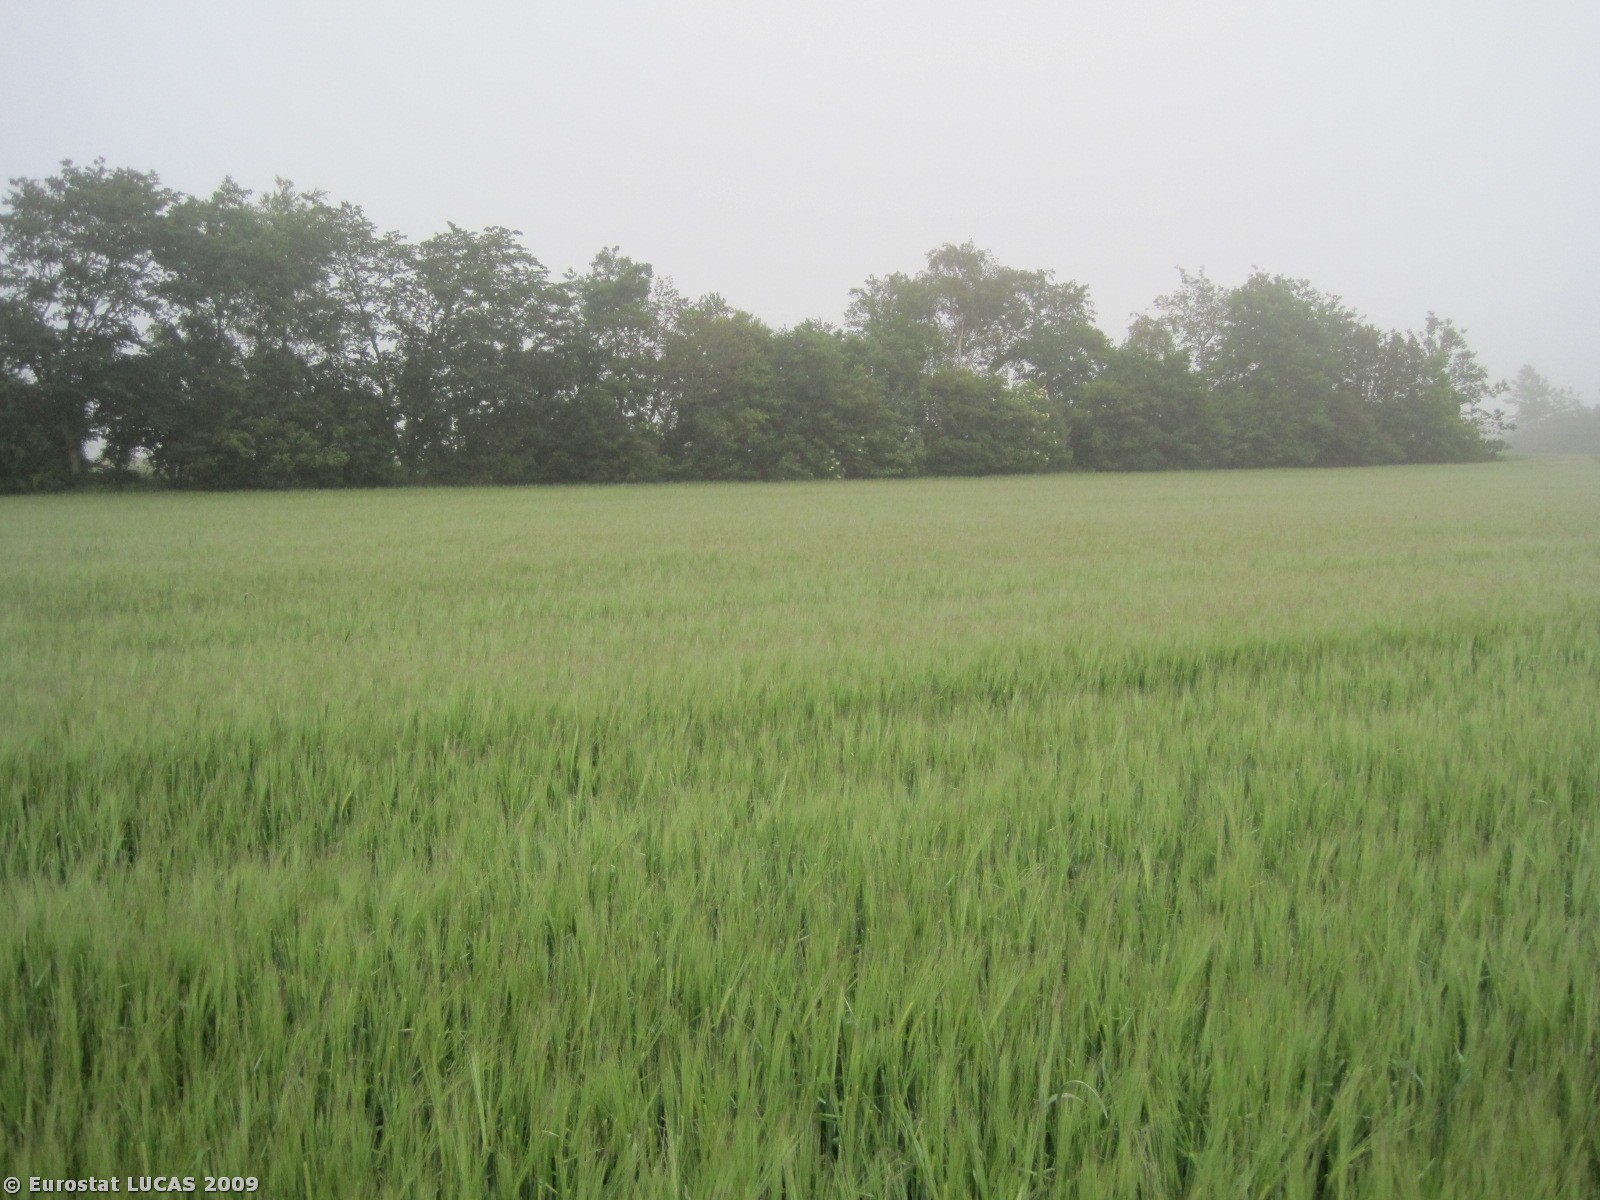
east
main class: Cropland
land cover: Barley
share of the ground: > 75 %
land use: Agriculture (excluding fallow land and kitchen gardens)
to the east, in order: Barley; Broadleaved woodland; Barley; Grass margins; Tracks; Grass margins; Barley
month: June
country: DK
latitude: 56.4893
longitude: 8.9781
